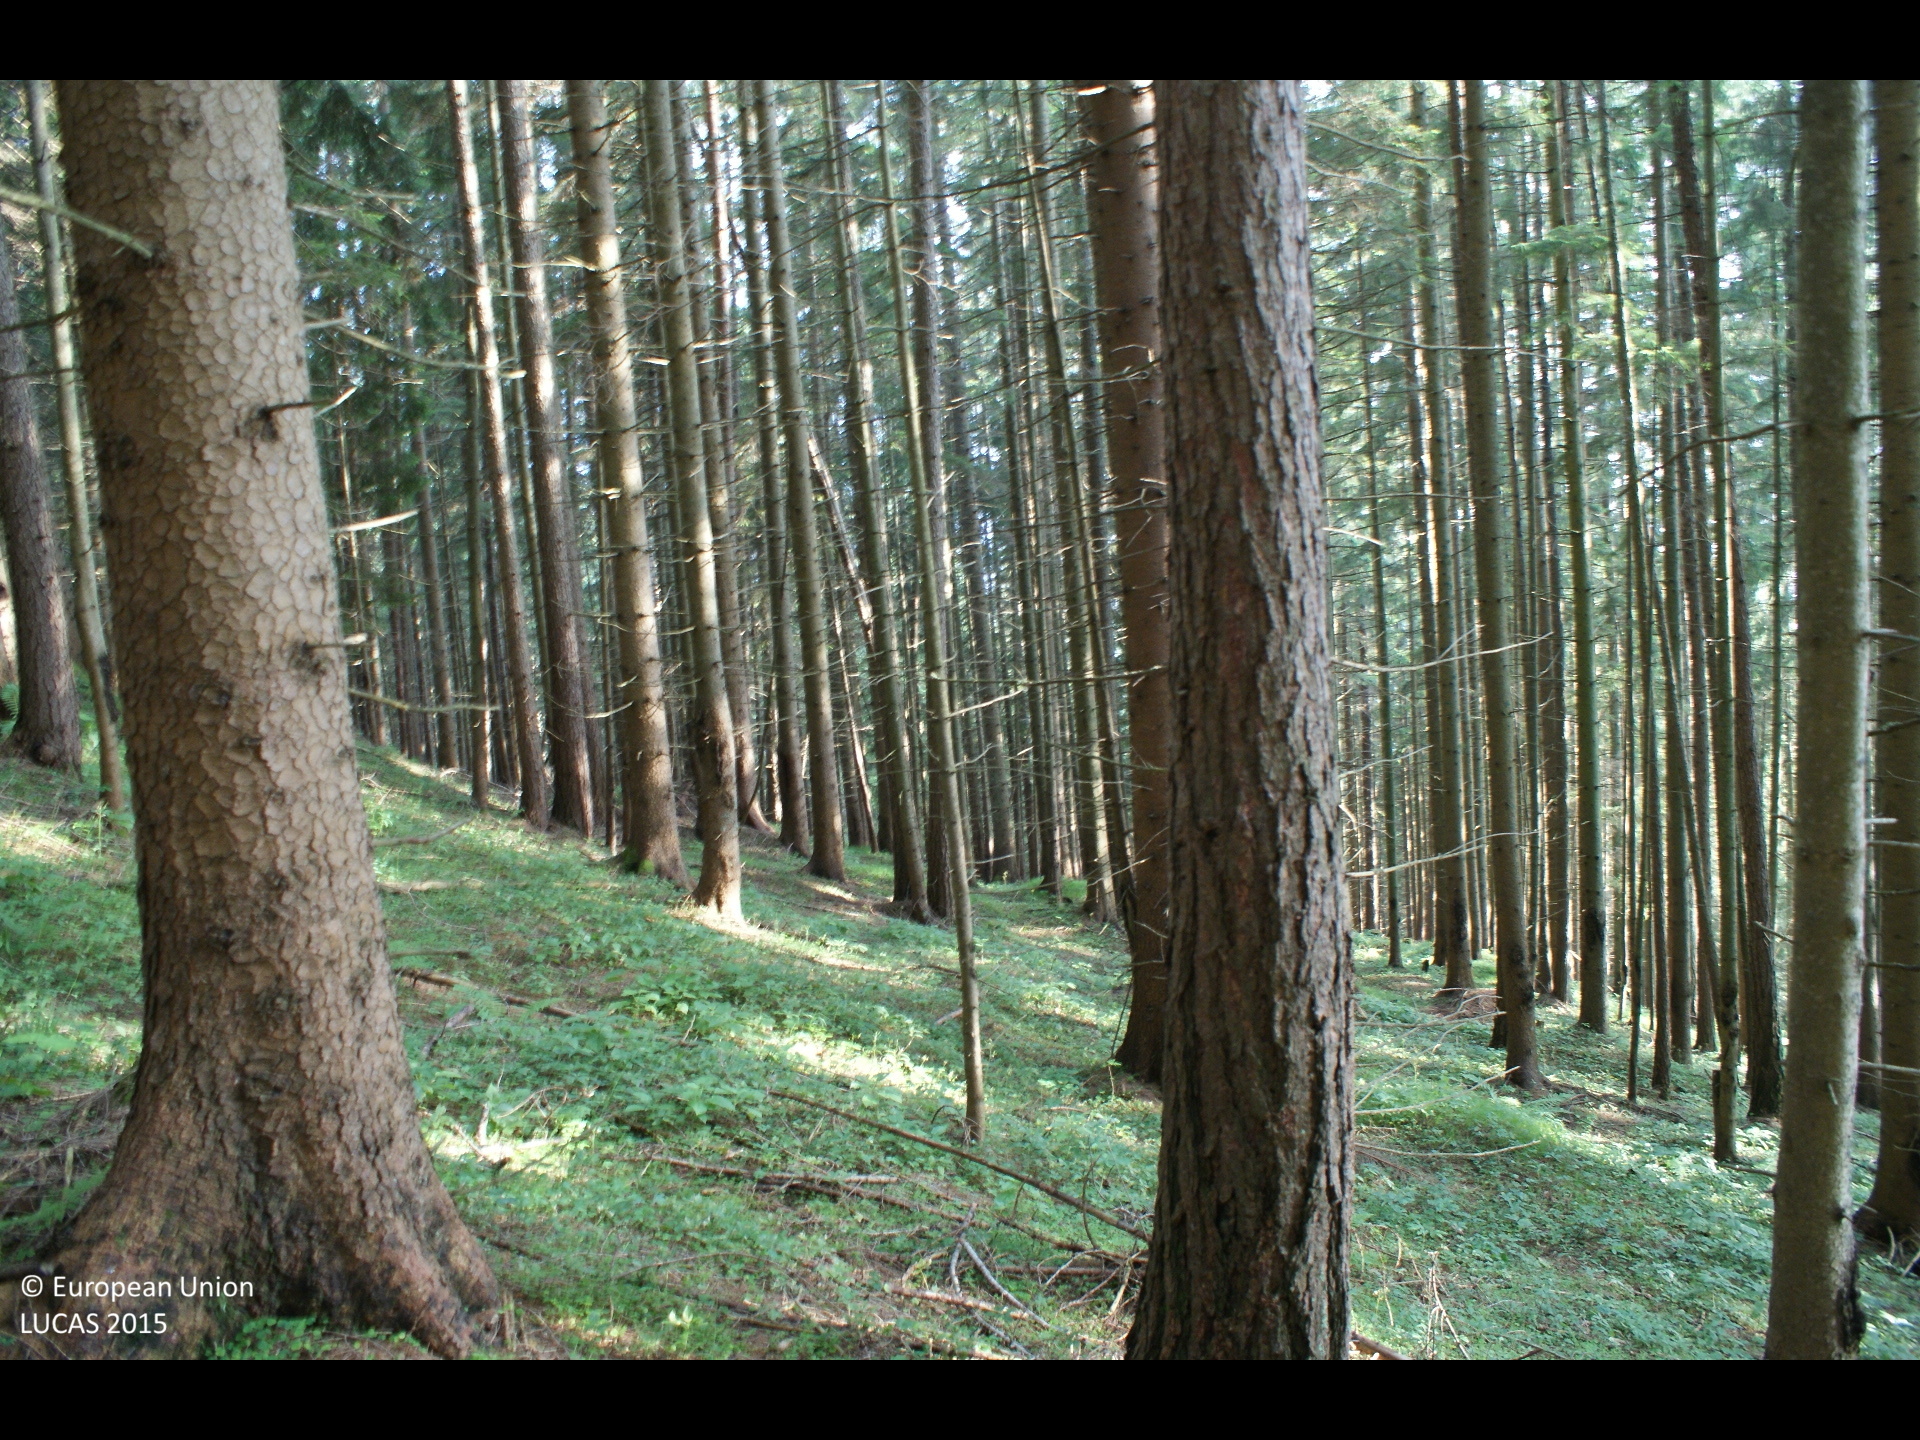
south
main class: Woodland
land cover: Spruce dominated coniferous woodland
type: alpine coniferous forest
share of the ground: > 75 %
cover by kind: coniferous forest trees 90 %, herbaceous plants 5 %, unconsolidated bare surface 5 %
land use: Forestry
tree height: > 5 m
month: August
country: AT
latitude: 47.7369
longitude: 15.2683
